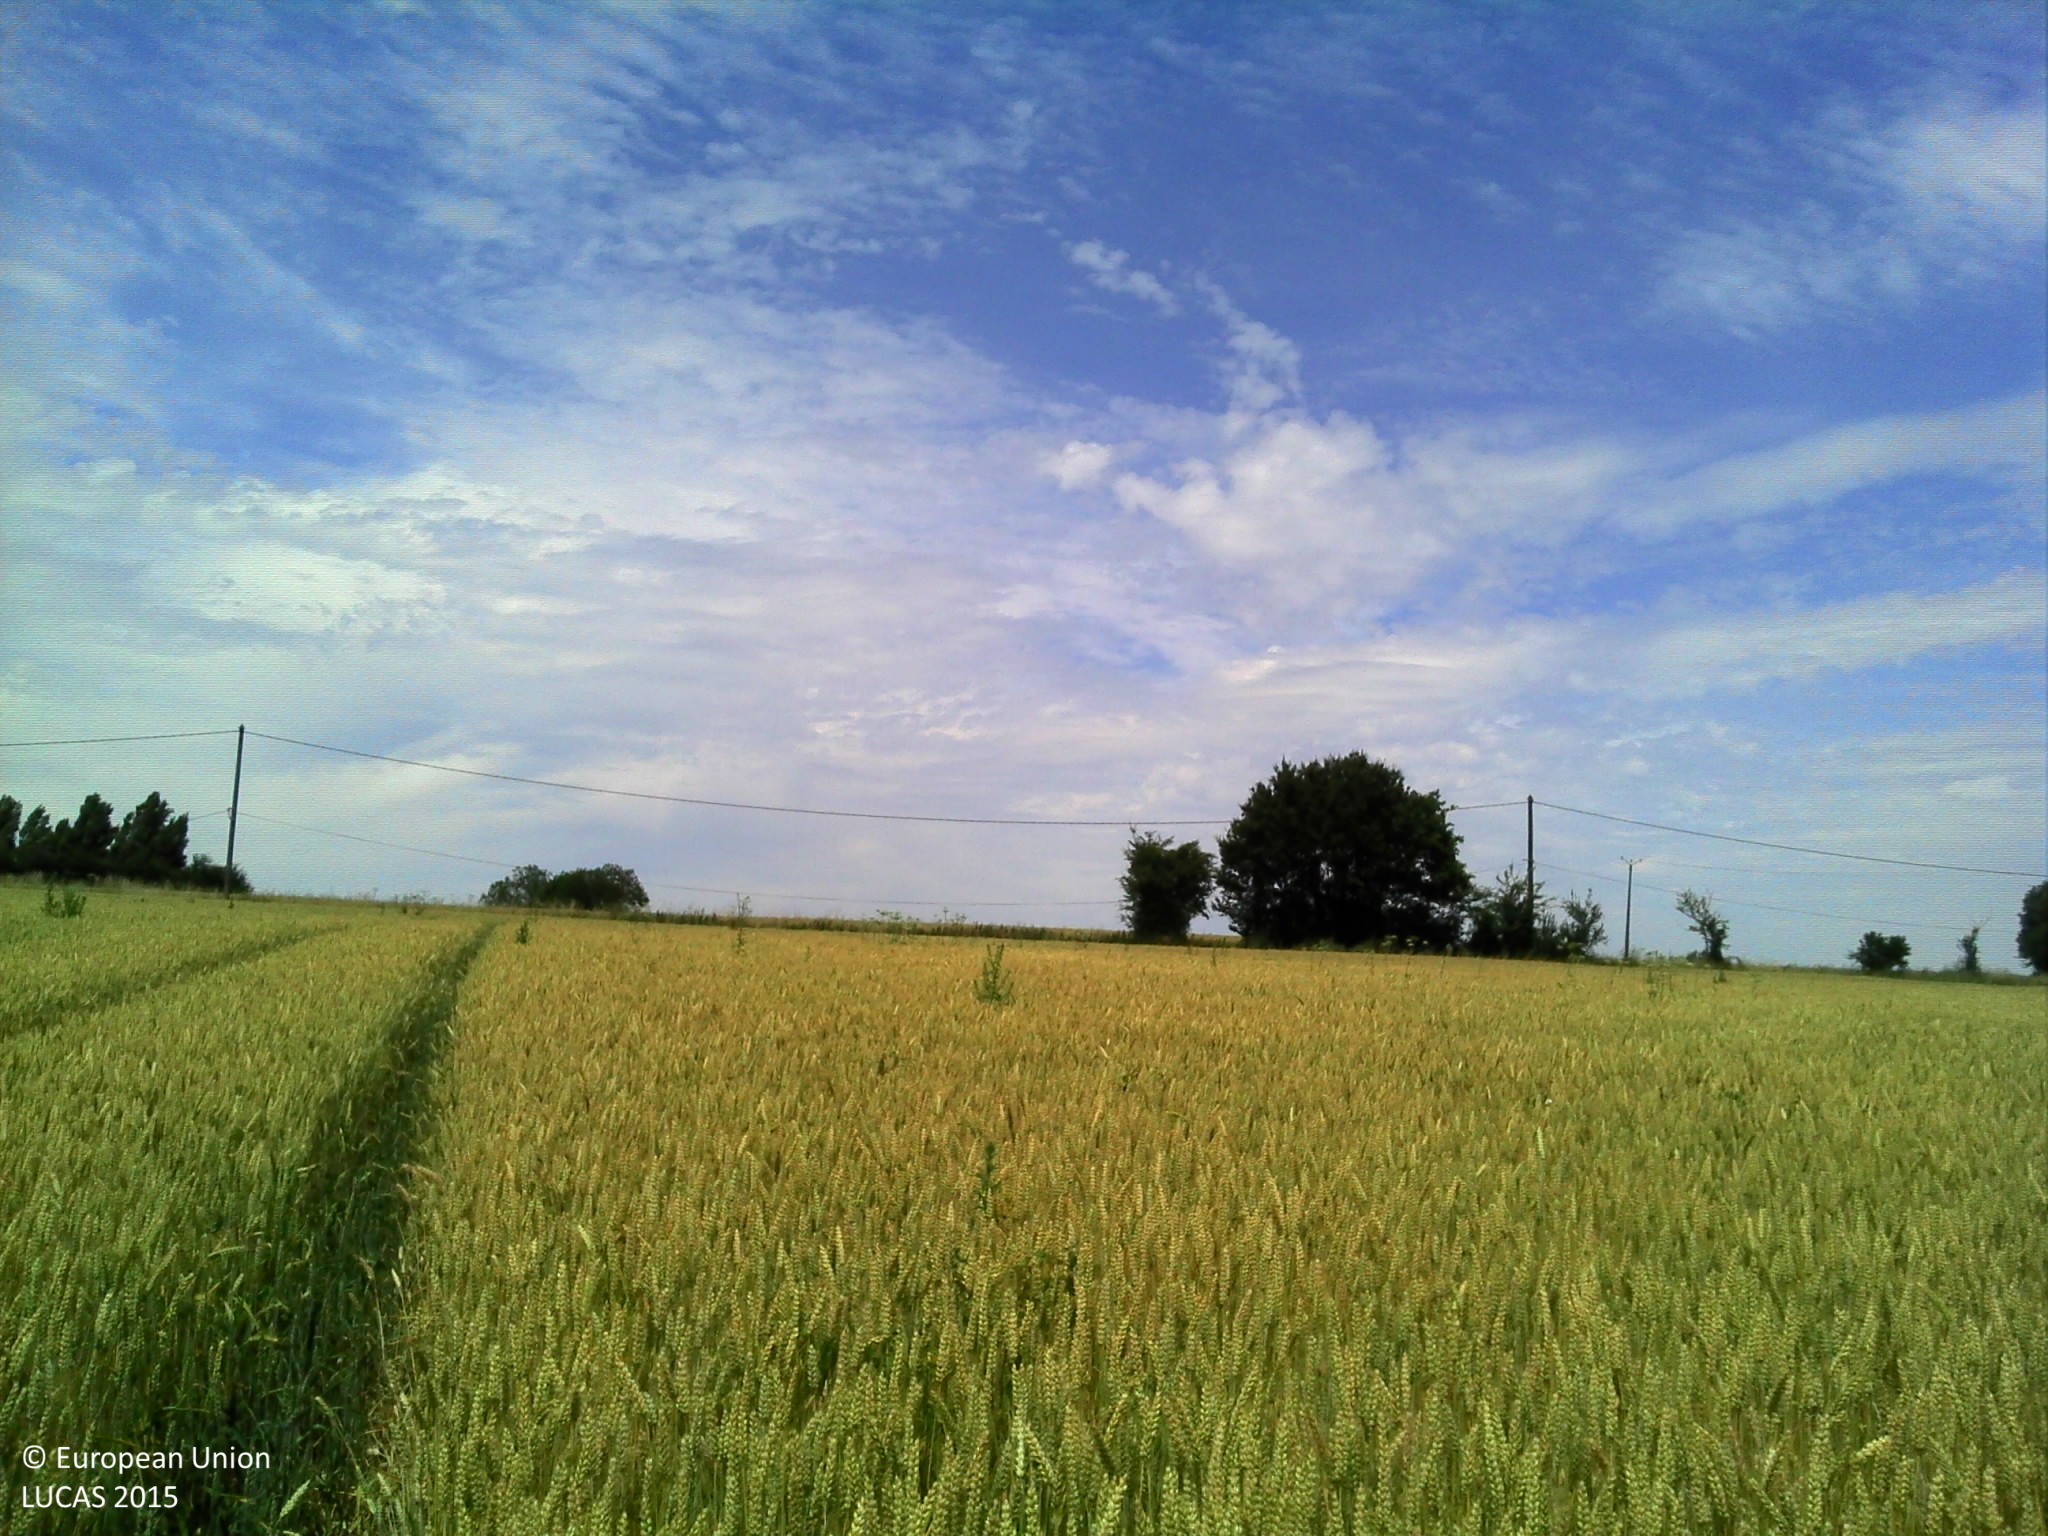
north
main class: Cropland
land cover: Common wheat
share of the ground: > 75 %
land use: Agriculture (excluding fallow land and kitchen gardens)
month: June
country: FR
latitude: 48.2887
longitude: 0.1472
